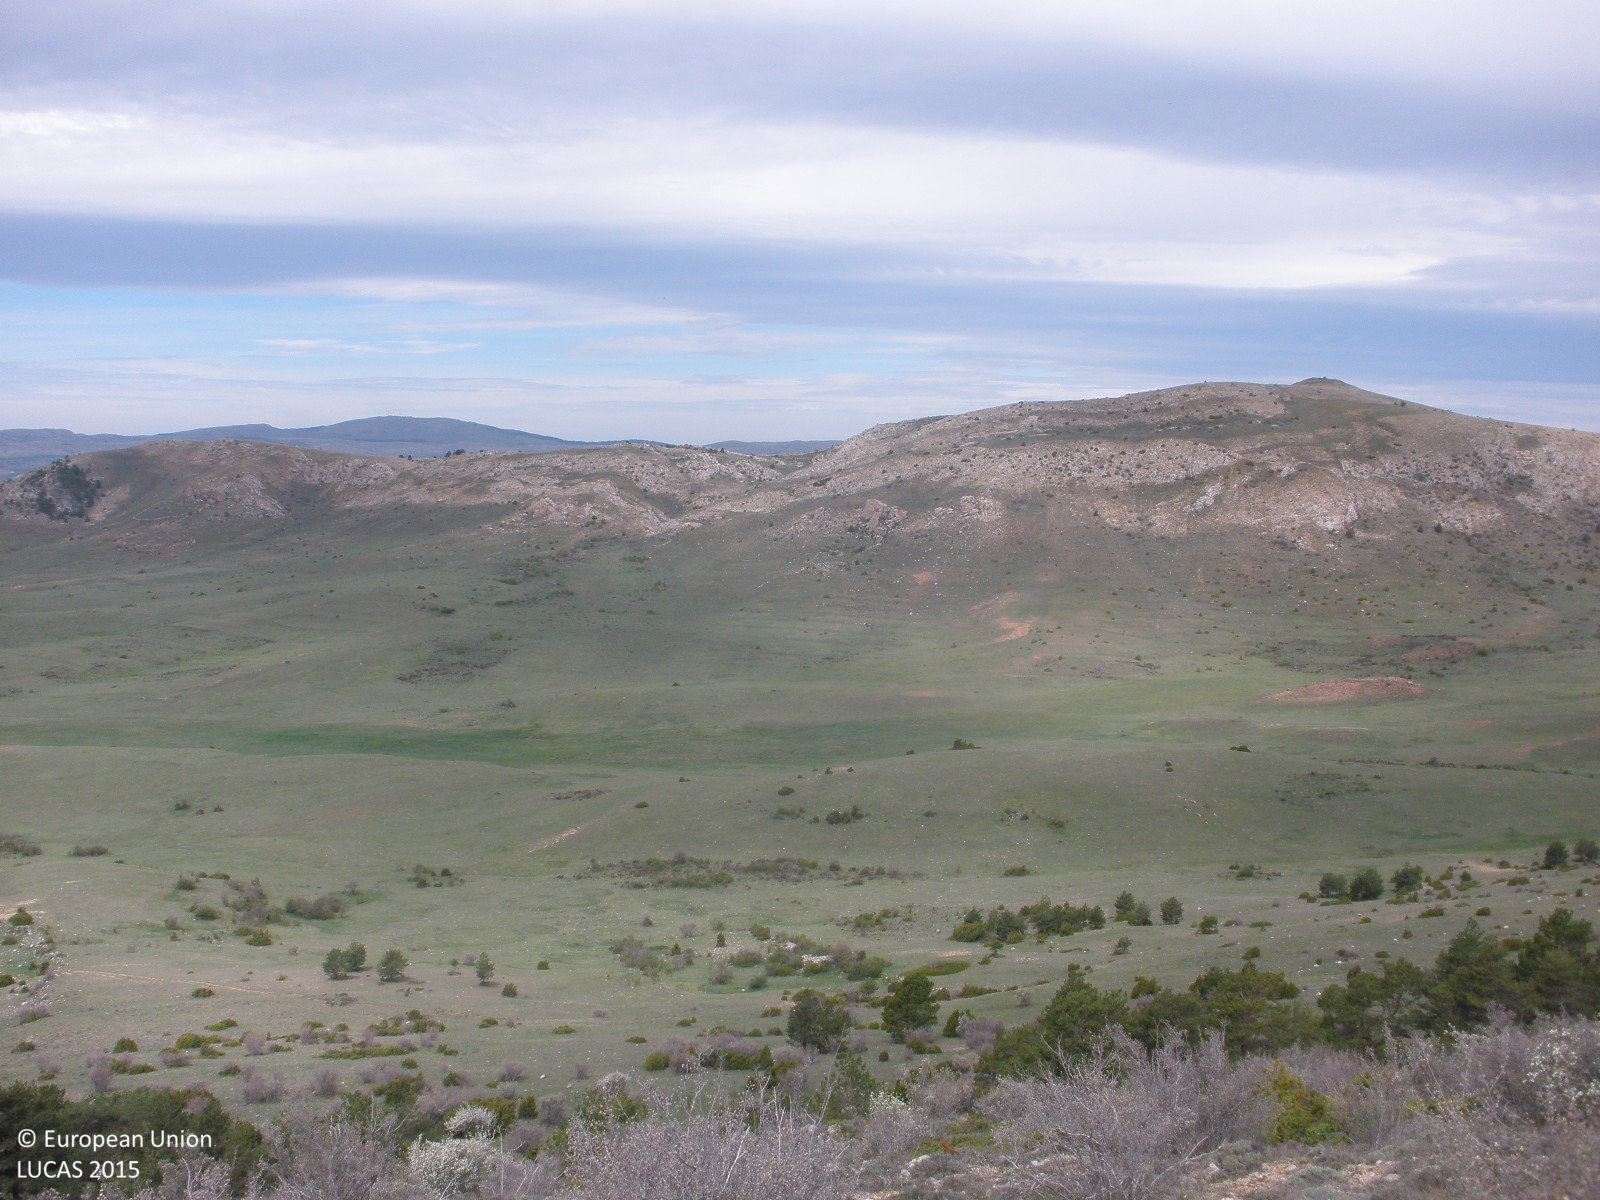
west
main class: Shrubland
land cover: Shrubland without tree cover
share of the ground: > 75 %
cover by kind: shrubs 75 %, herbaceous plants 15 %, consolidated bare surface 10 %
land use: Agriculture (excluding fallow land and kitchen gardens)
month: May
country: ES
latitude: 40.4562
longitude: -0.7758
